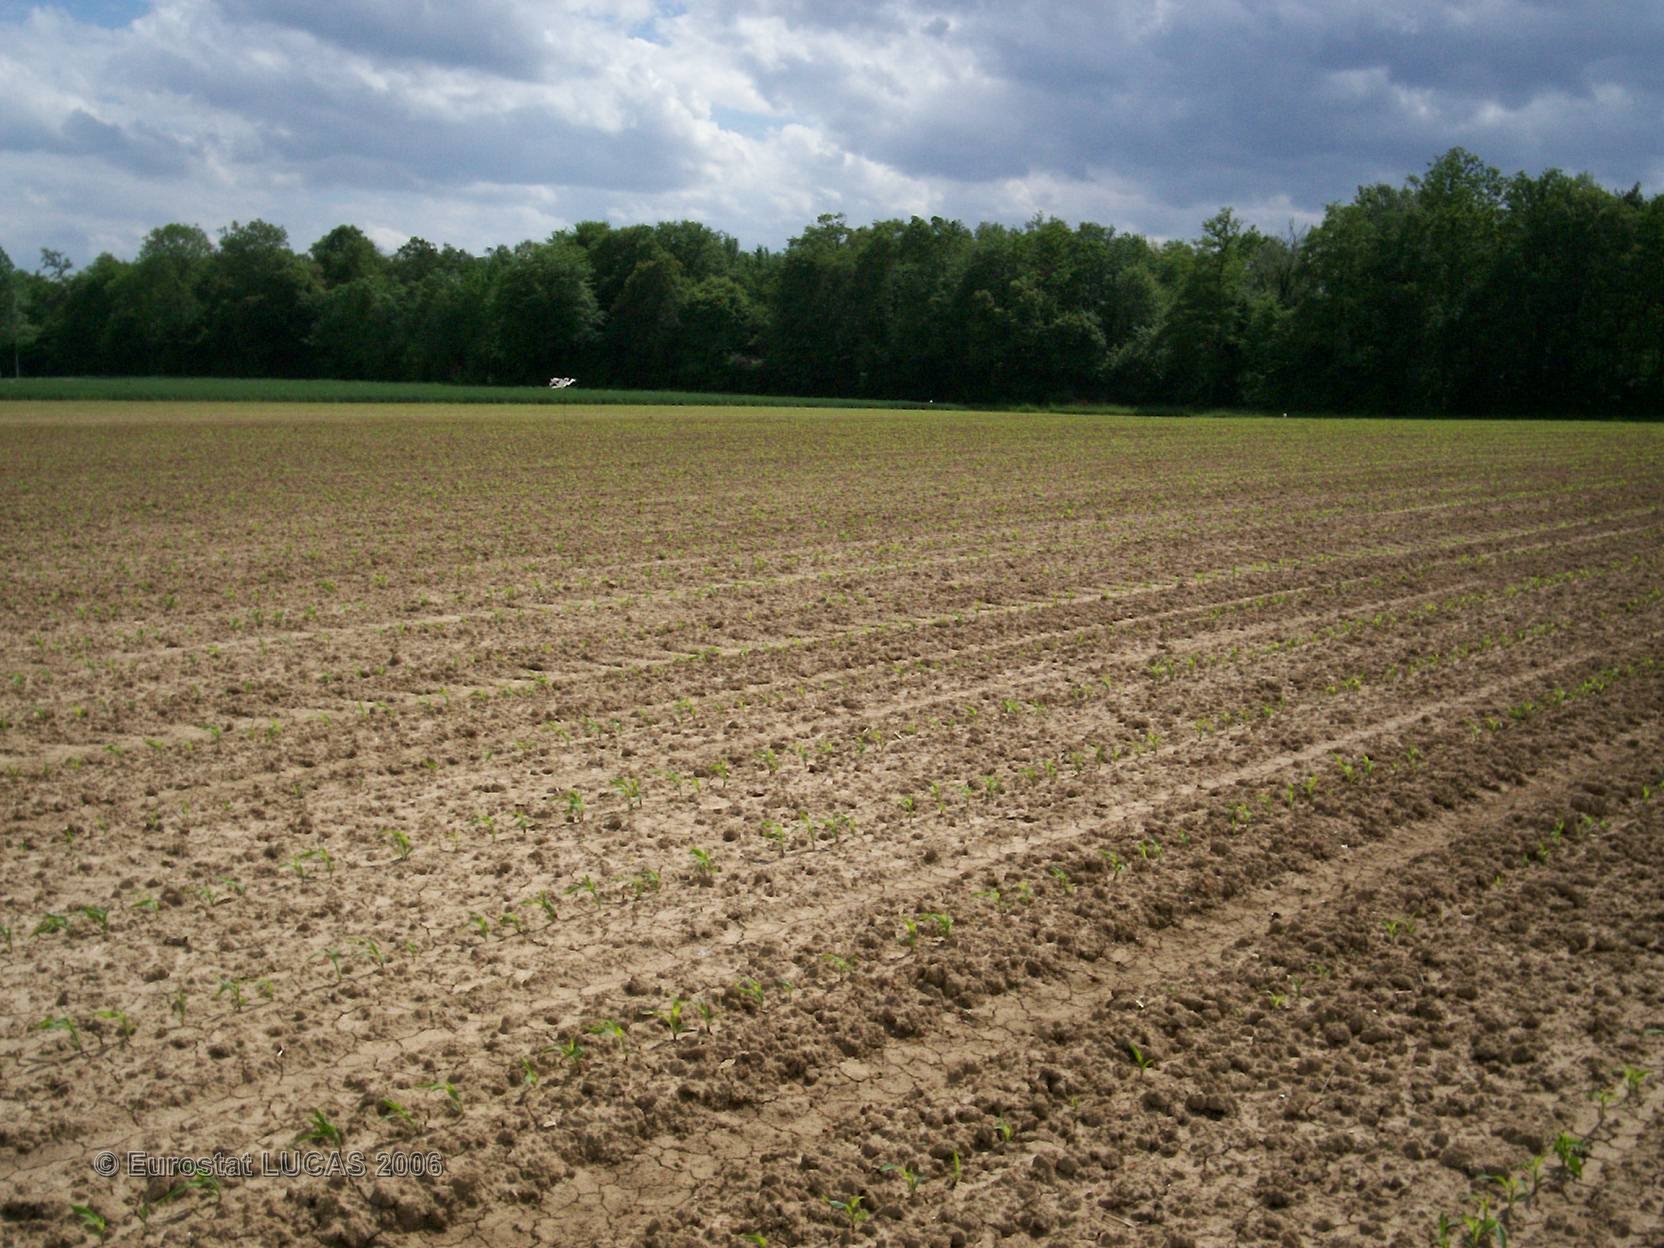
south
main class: Cropland
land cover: Maize
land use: Agriculture (excluding fallow land and kitchen gardens)
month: May
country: FR
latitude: 48.3723
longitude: 4.4489
